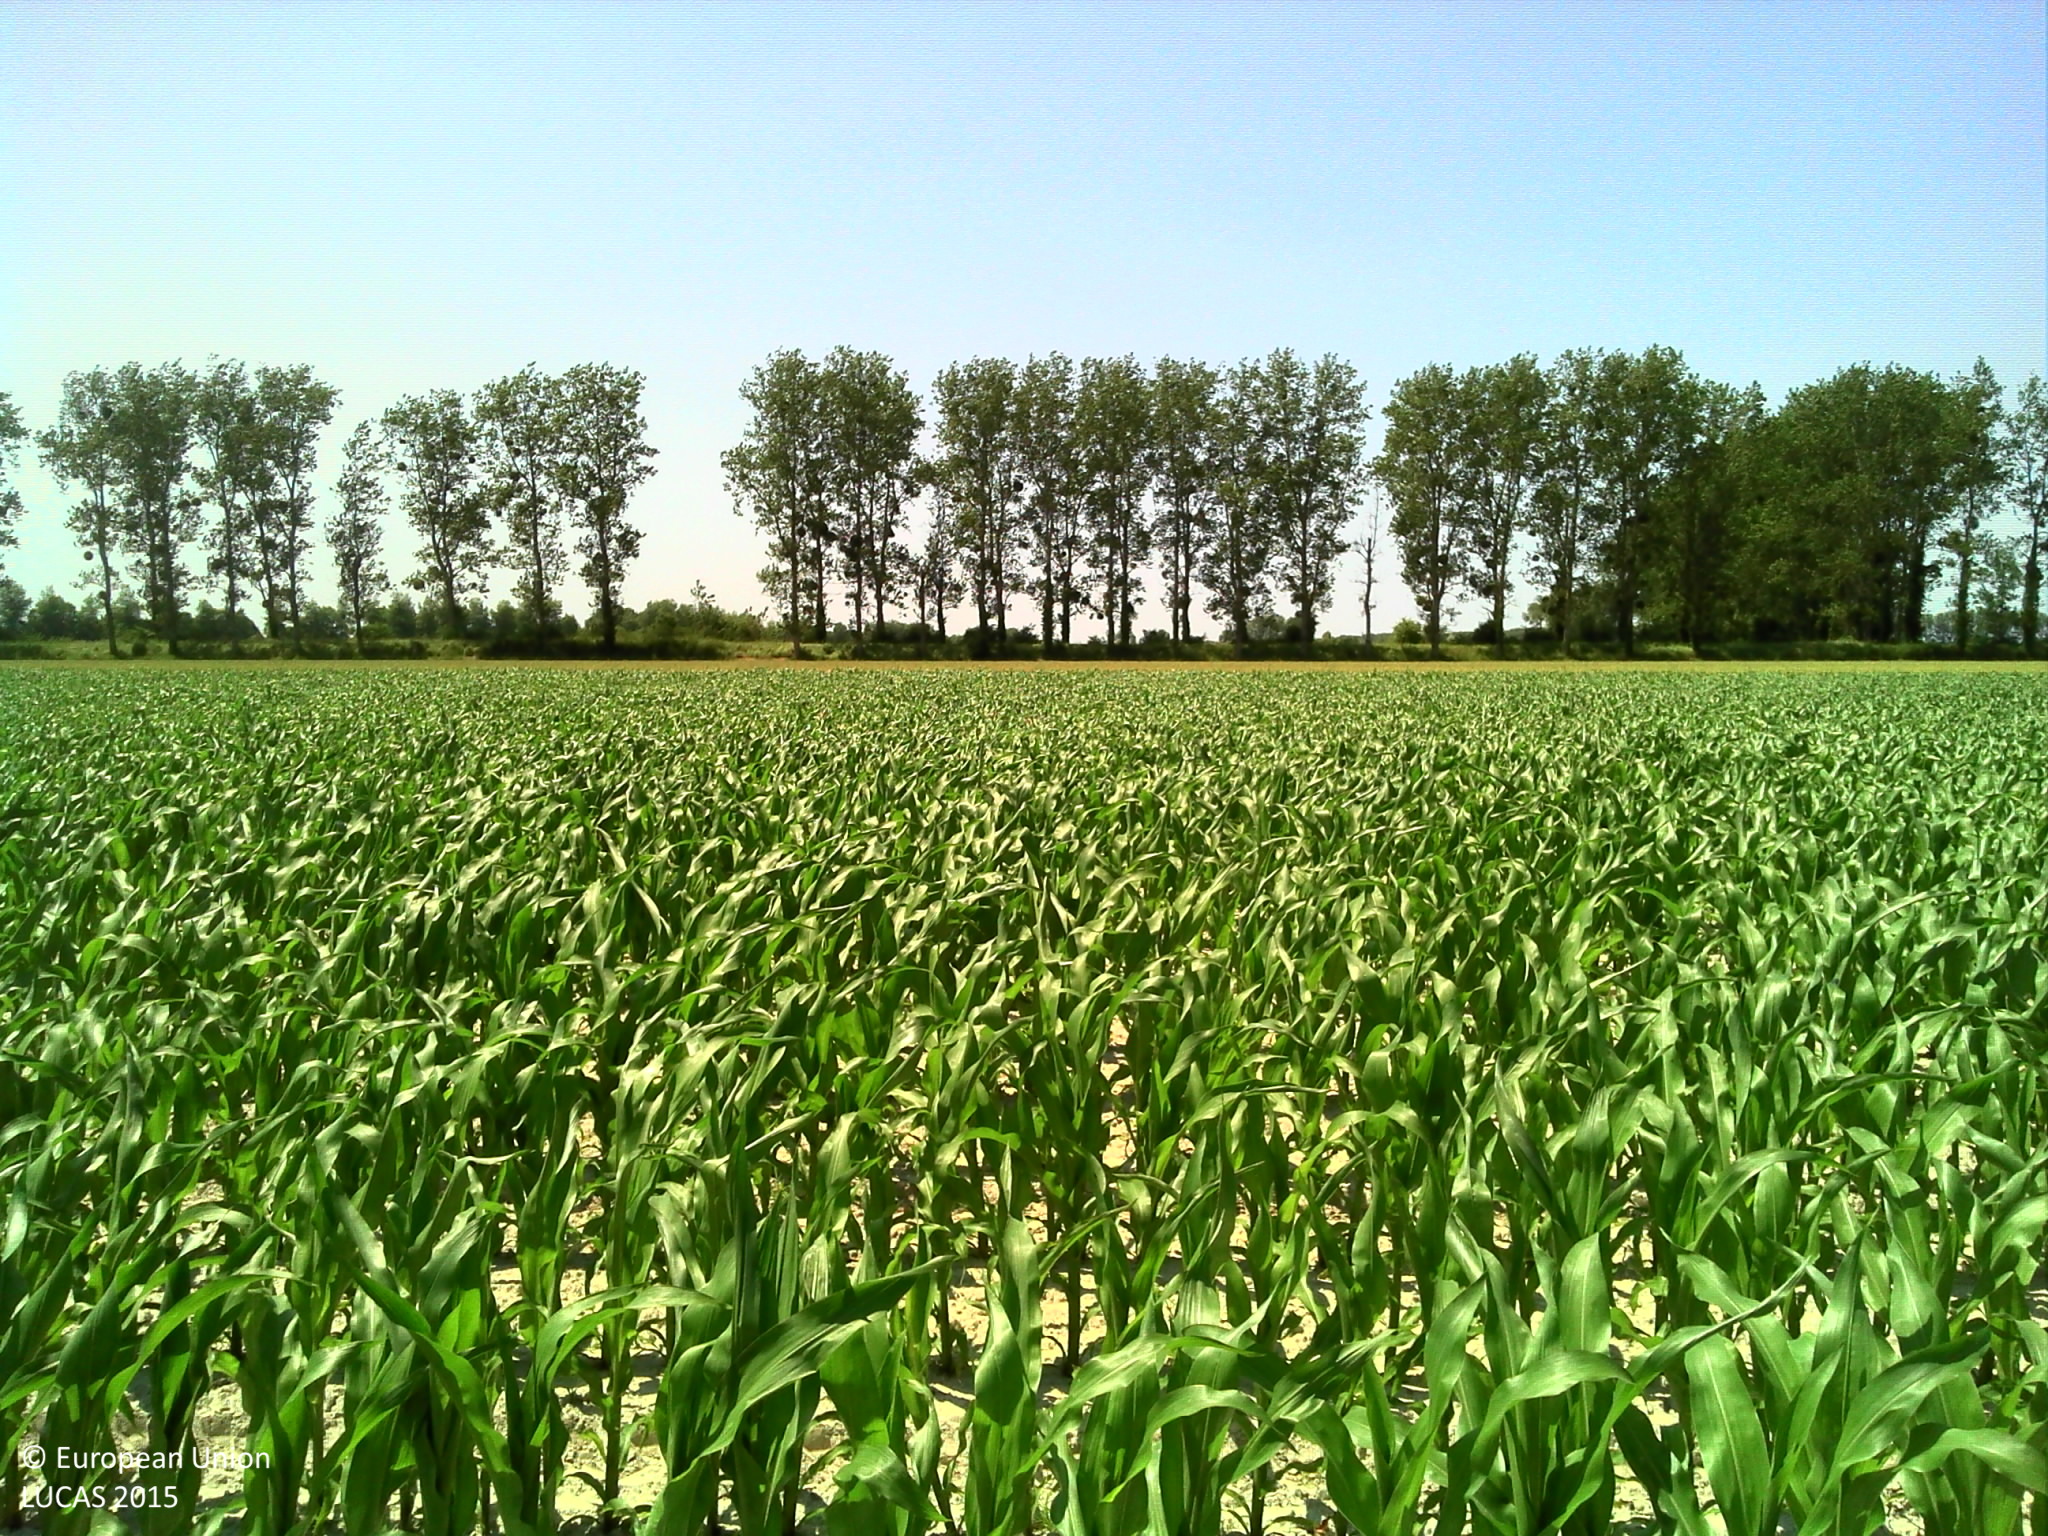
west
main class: Cropland
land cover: Maize
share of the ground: 25 - 50 %
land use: Agriculture (excluding fallow land and kitchen gardens)
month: June
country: FR
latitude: 48.6095
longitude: -1.5907
